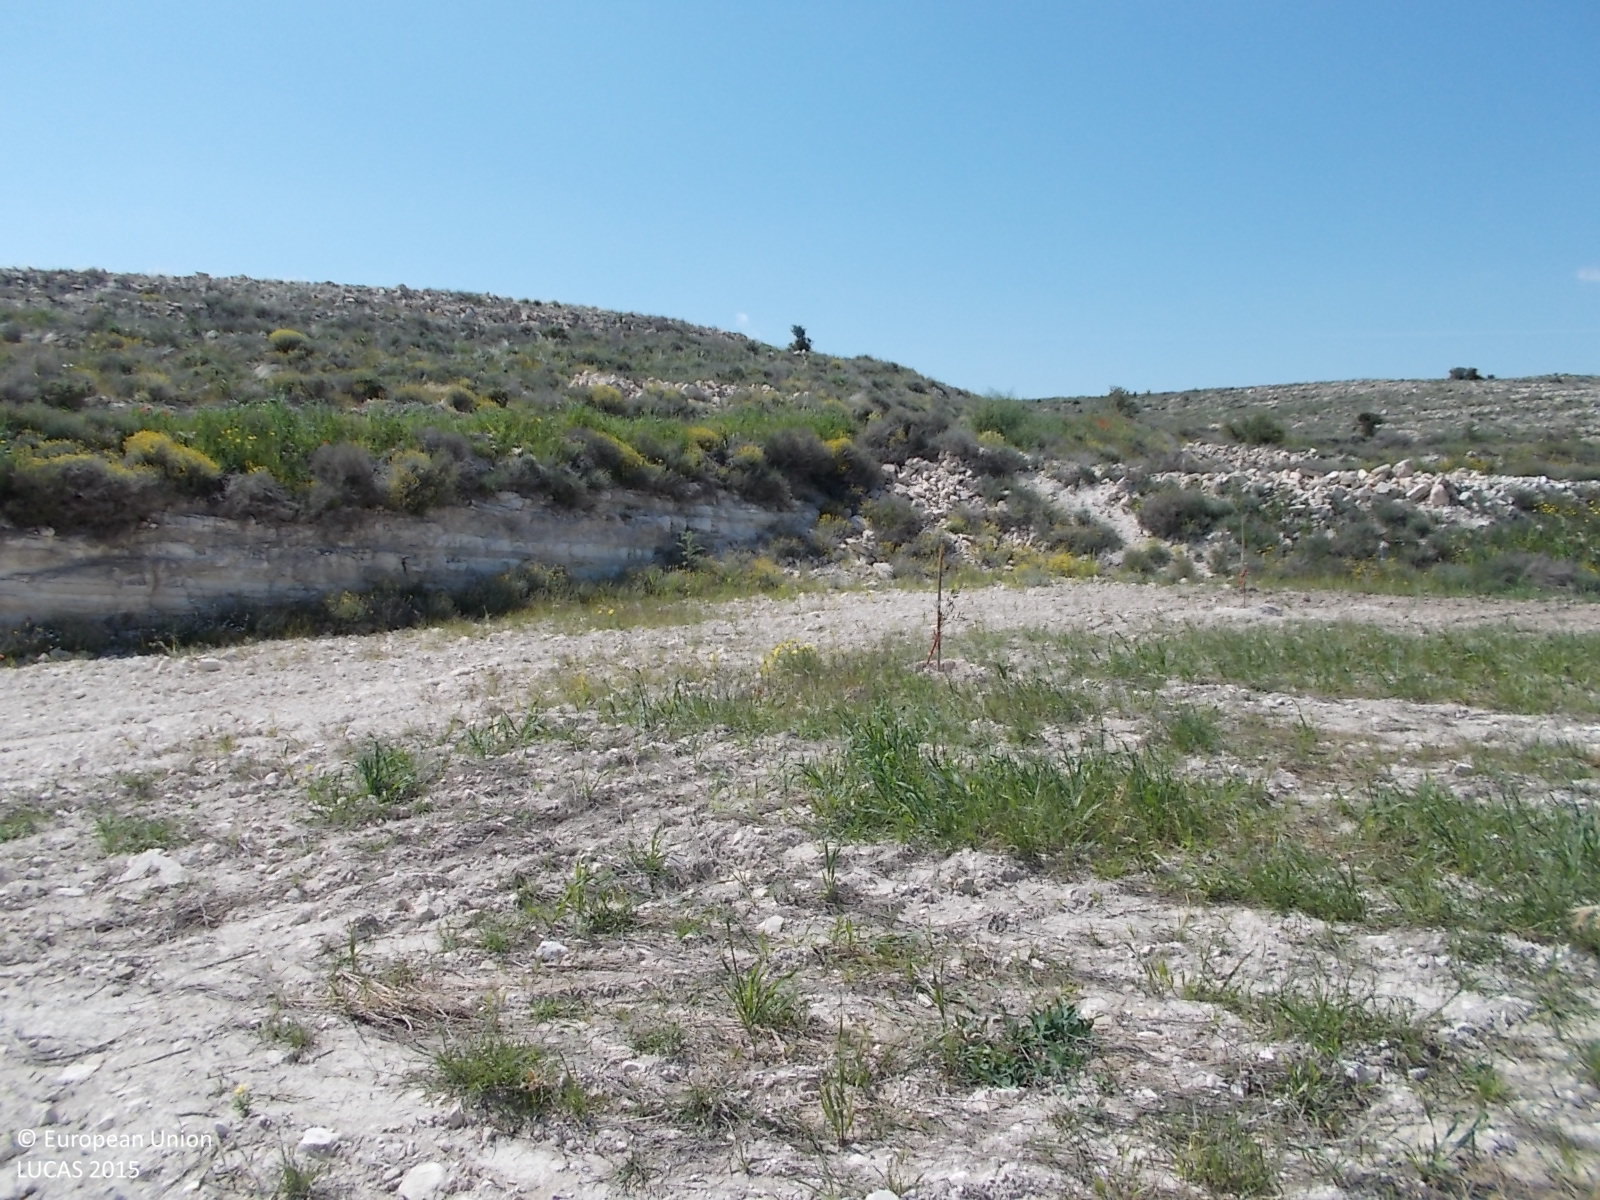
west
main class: Cropland
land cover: Olive groves
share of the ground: < 10 %
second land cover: Grassland without tree/shrub cover
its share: 25 - 50 %
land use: Agriculture (excluding fallow land and kitchen gardens)
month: April
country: CY
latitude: 35.0089
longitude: 33.5476
